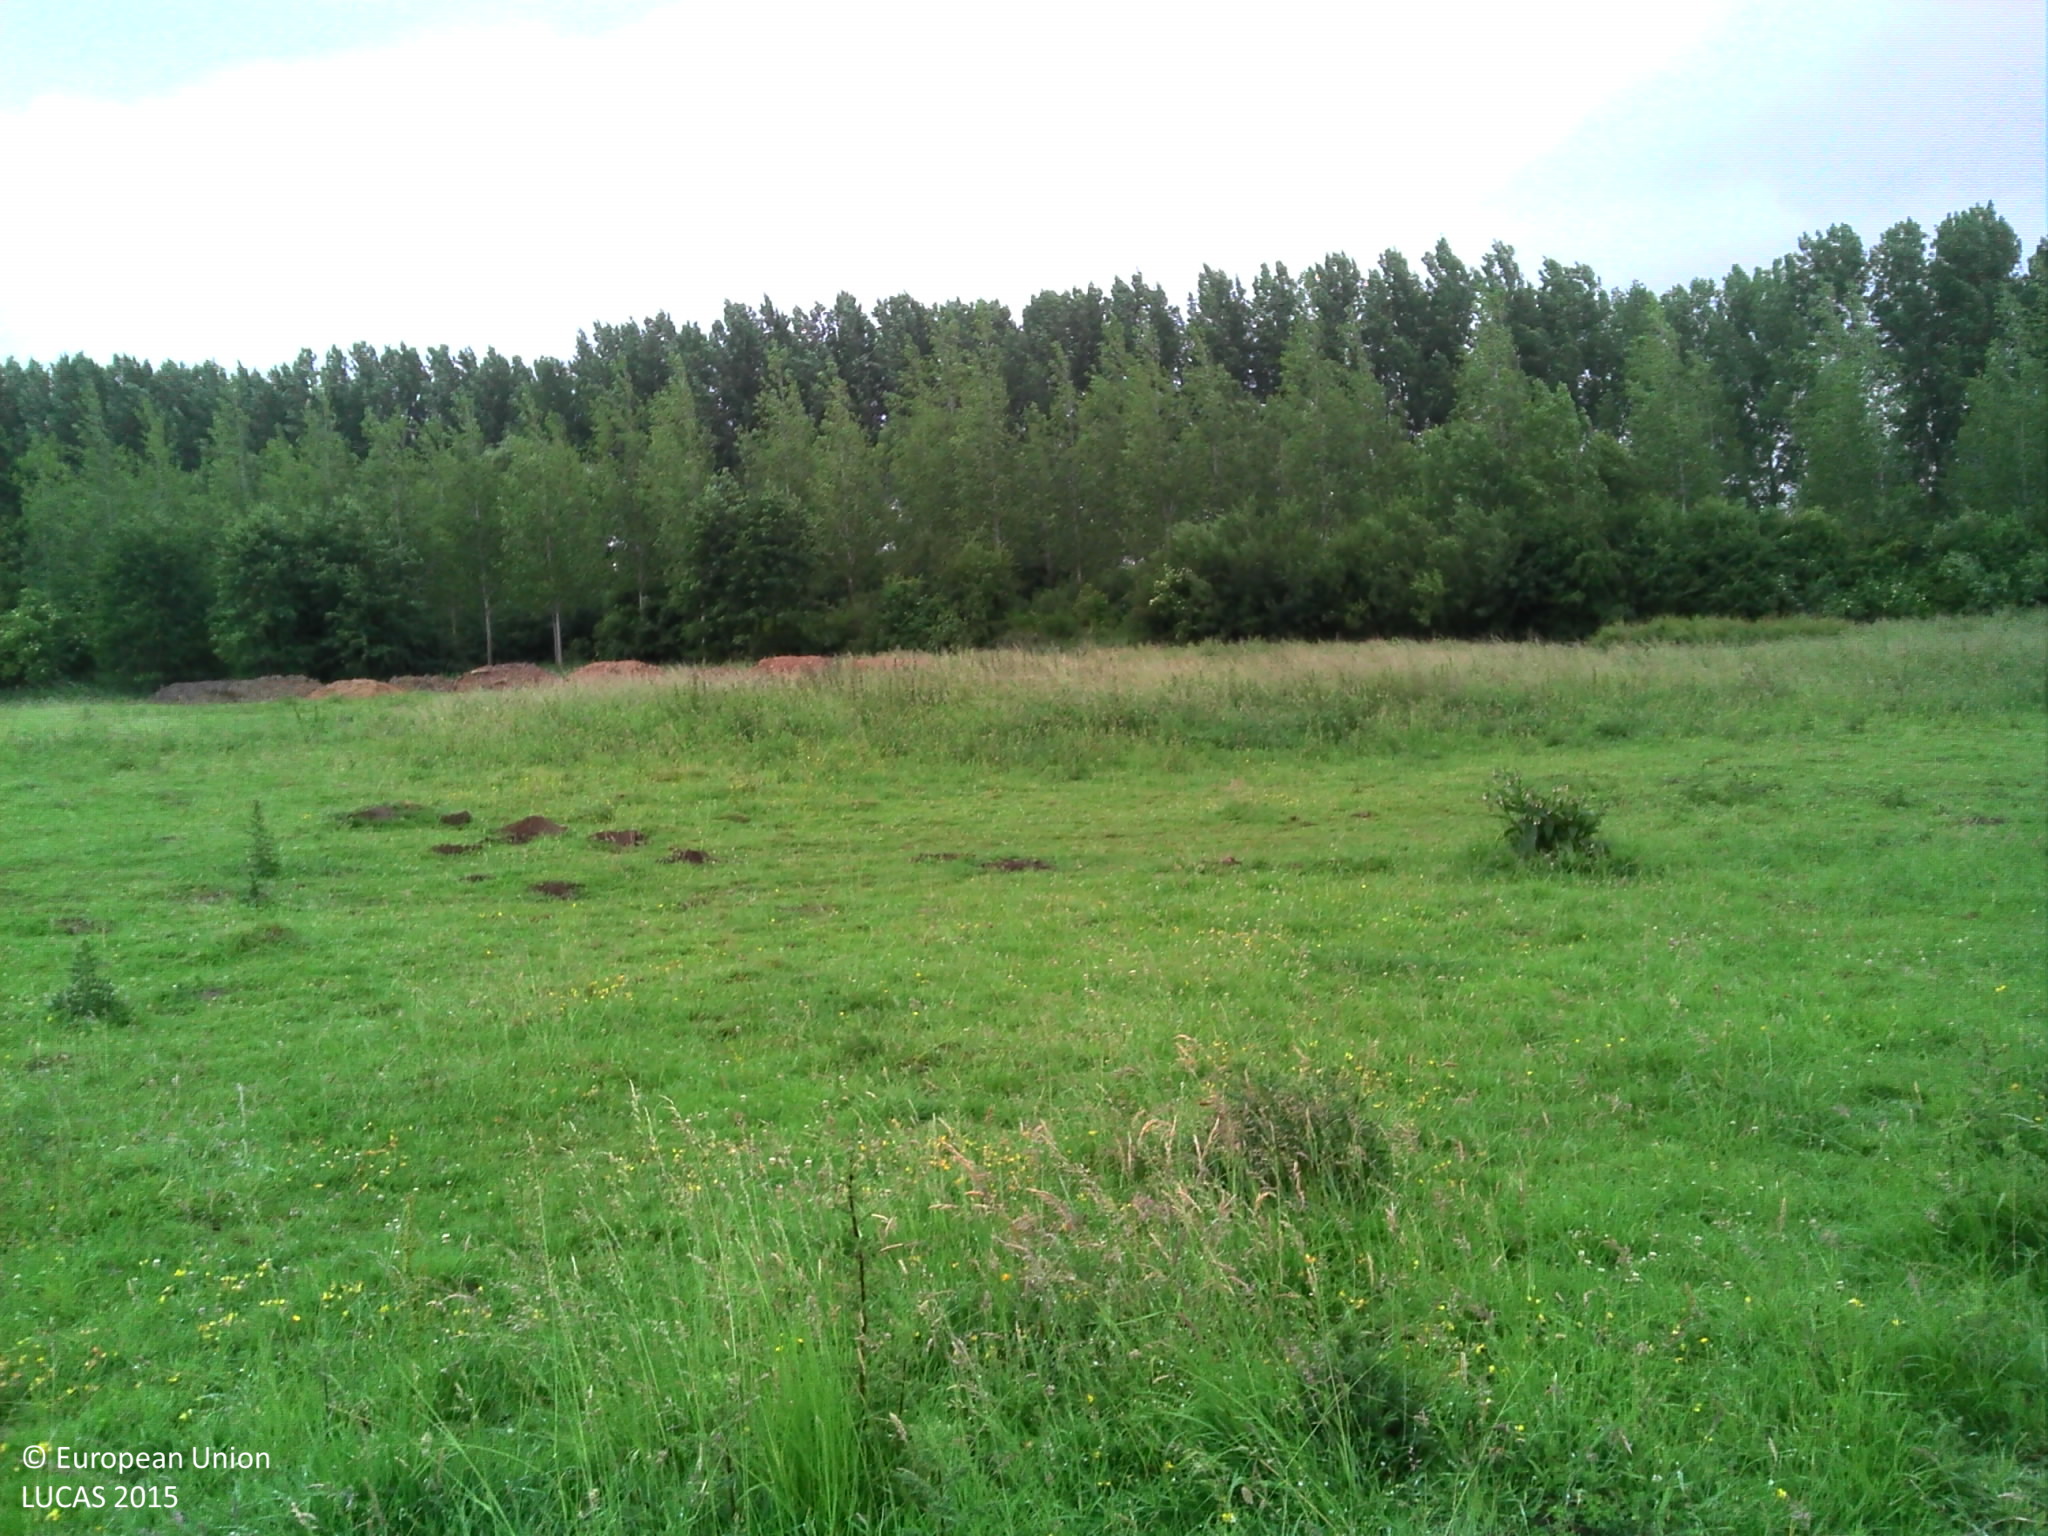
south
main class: Grassland
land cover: Grassland without tree/shrub cover
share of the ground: > 75 %
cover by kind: herbaceous plants 100 %
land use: Agriculture (excluding fallow land and kitchen gardens)
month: June
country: BE
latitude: 50.4428
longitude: 3.6988
